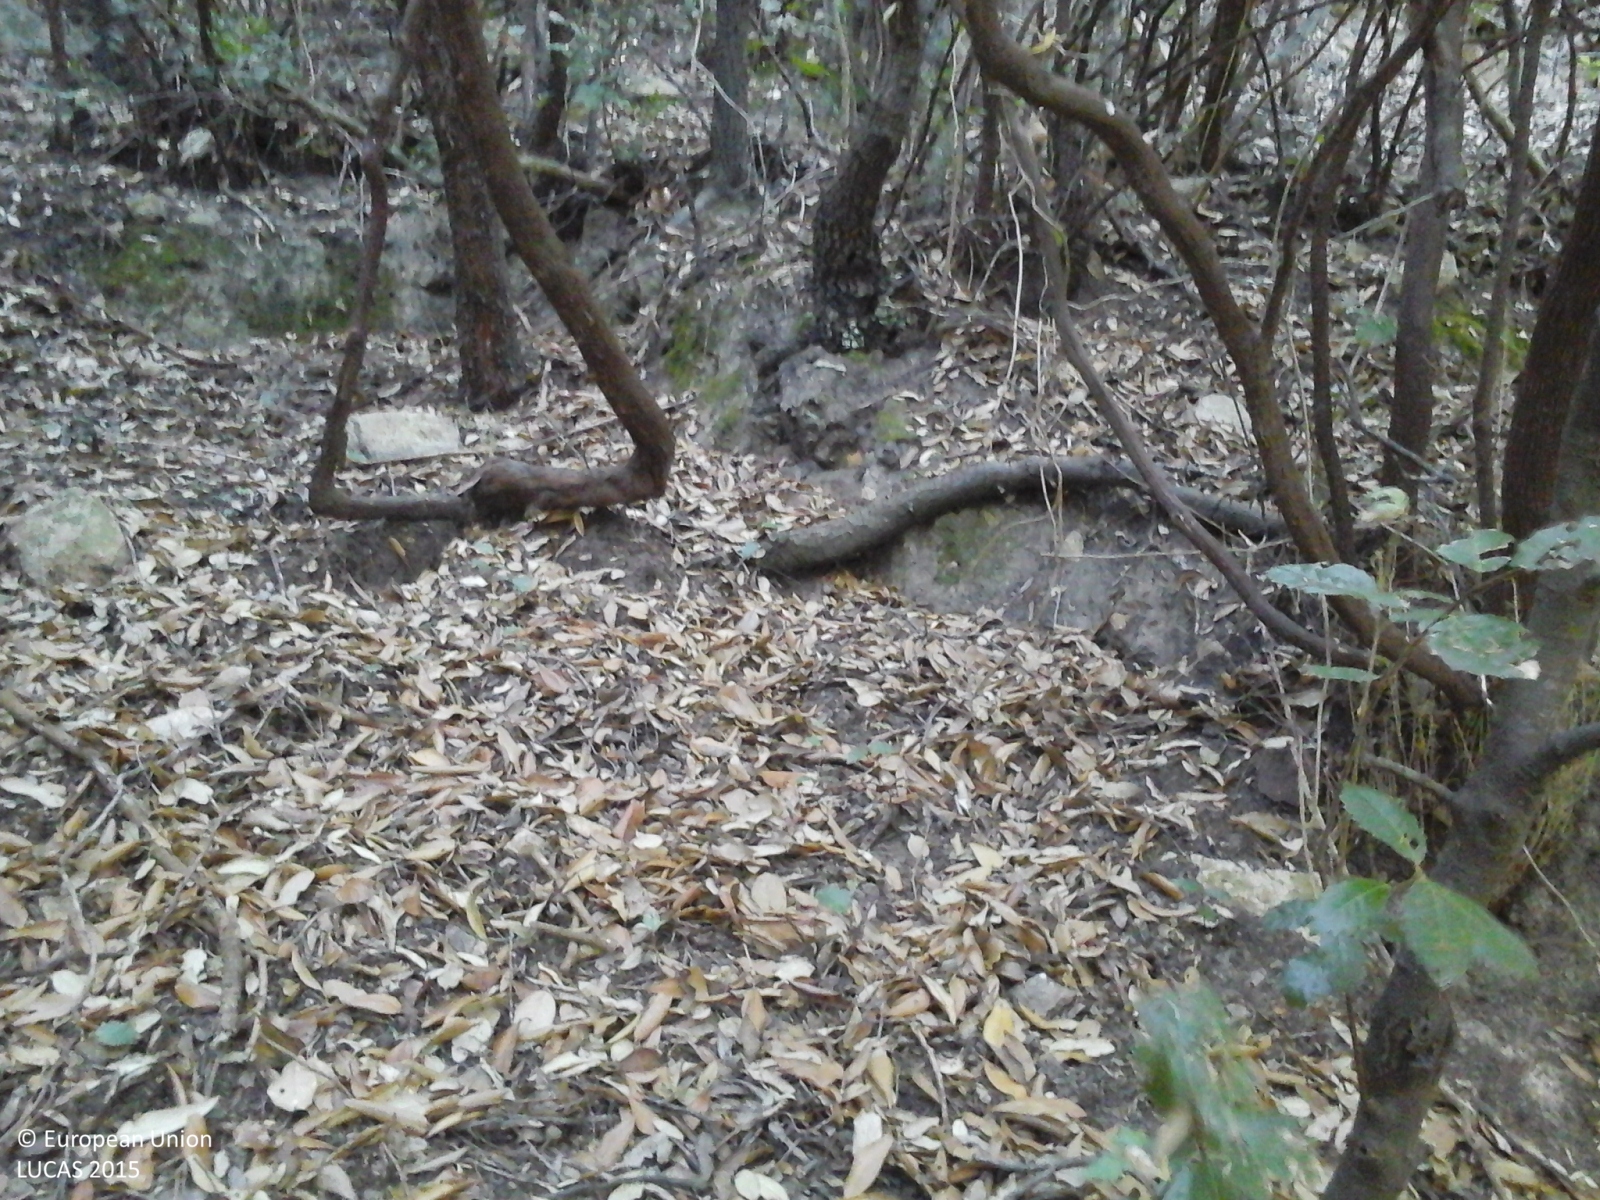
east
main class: Woodland
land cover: Broadleaved woodland
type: broadleaved evergreen forest
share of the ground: > 75 %
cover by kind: broadleaved forest trees 100 %
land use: Semi-natural and natural areas not in use
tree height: > 5 m
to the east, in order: Broadleaved woodland
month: July
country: IT
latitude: 42.8162
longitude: 10.2804
